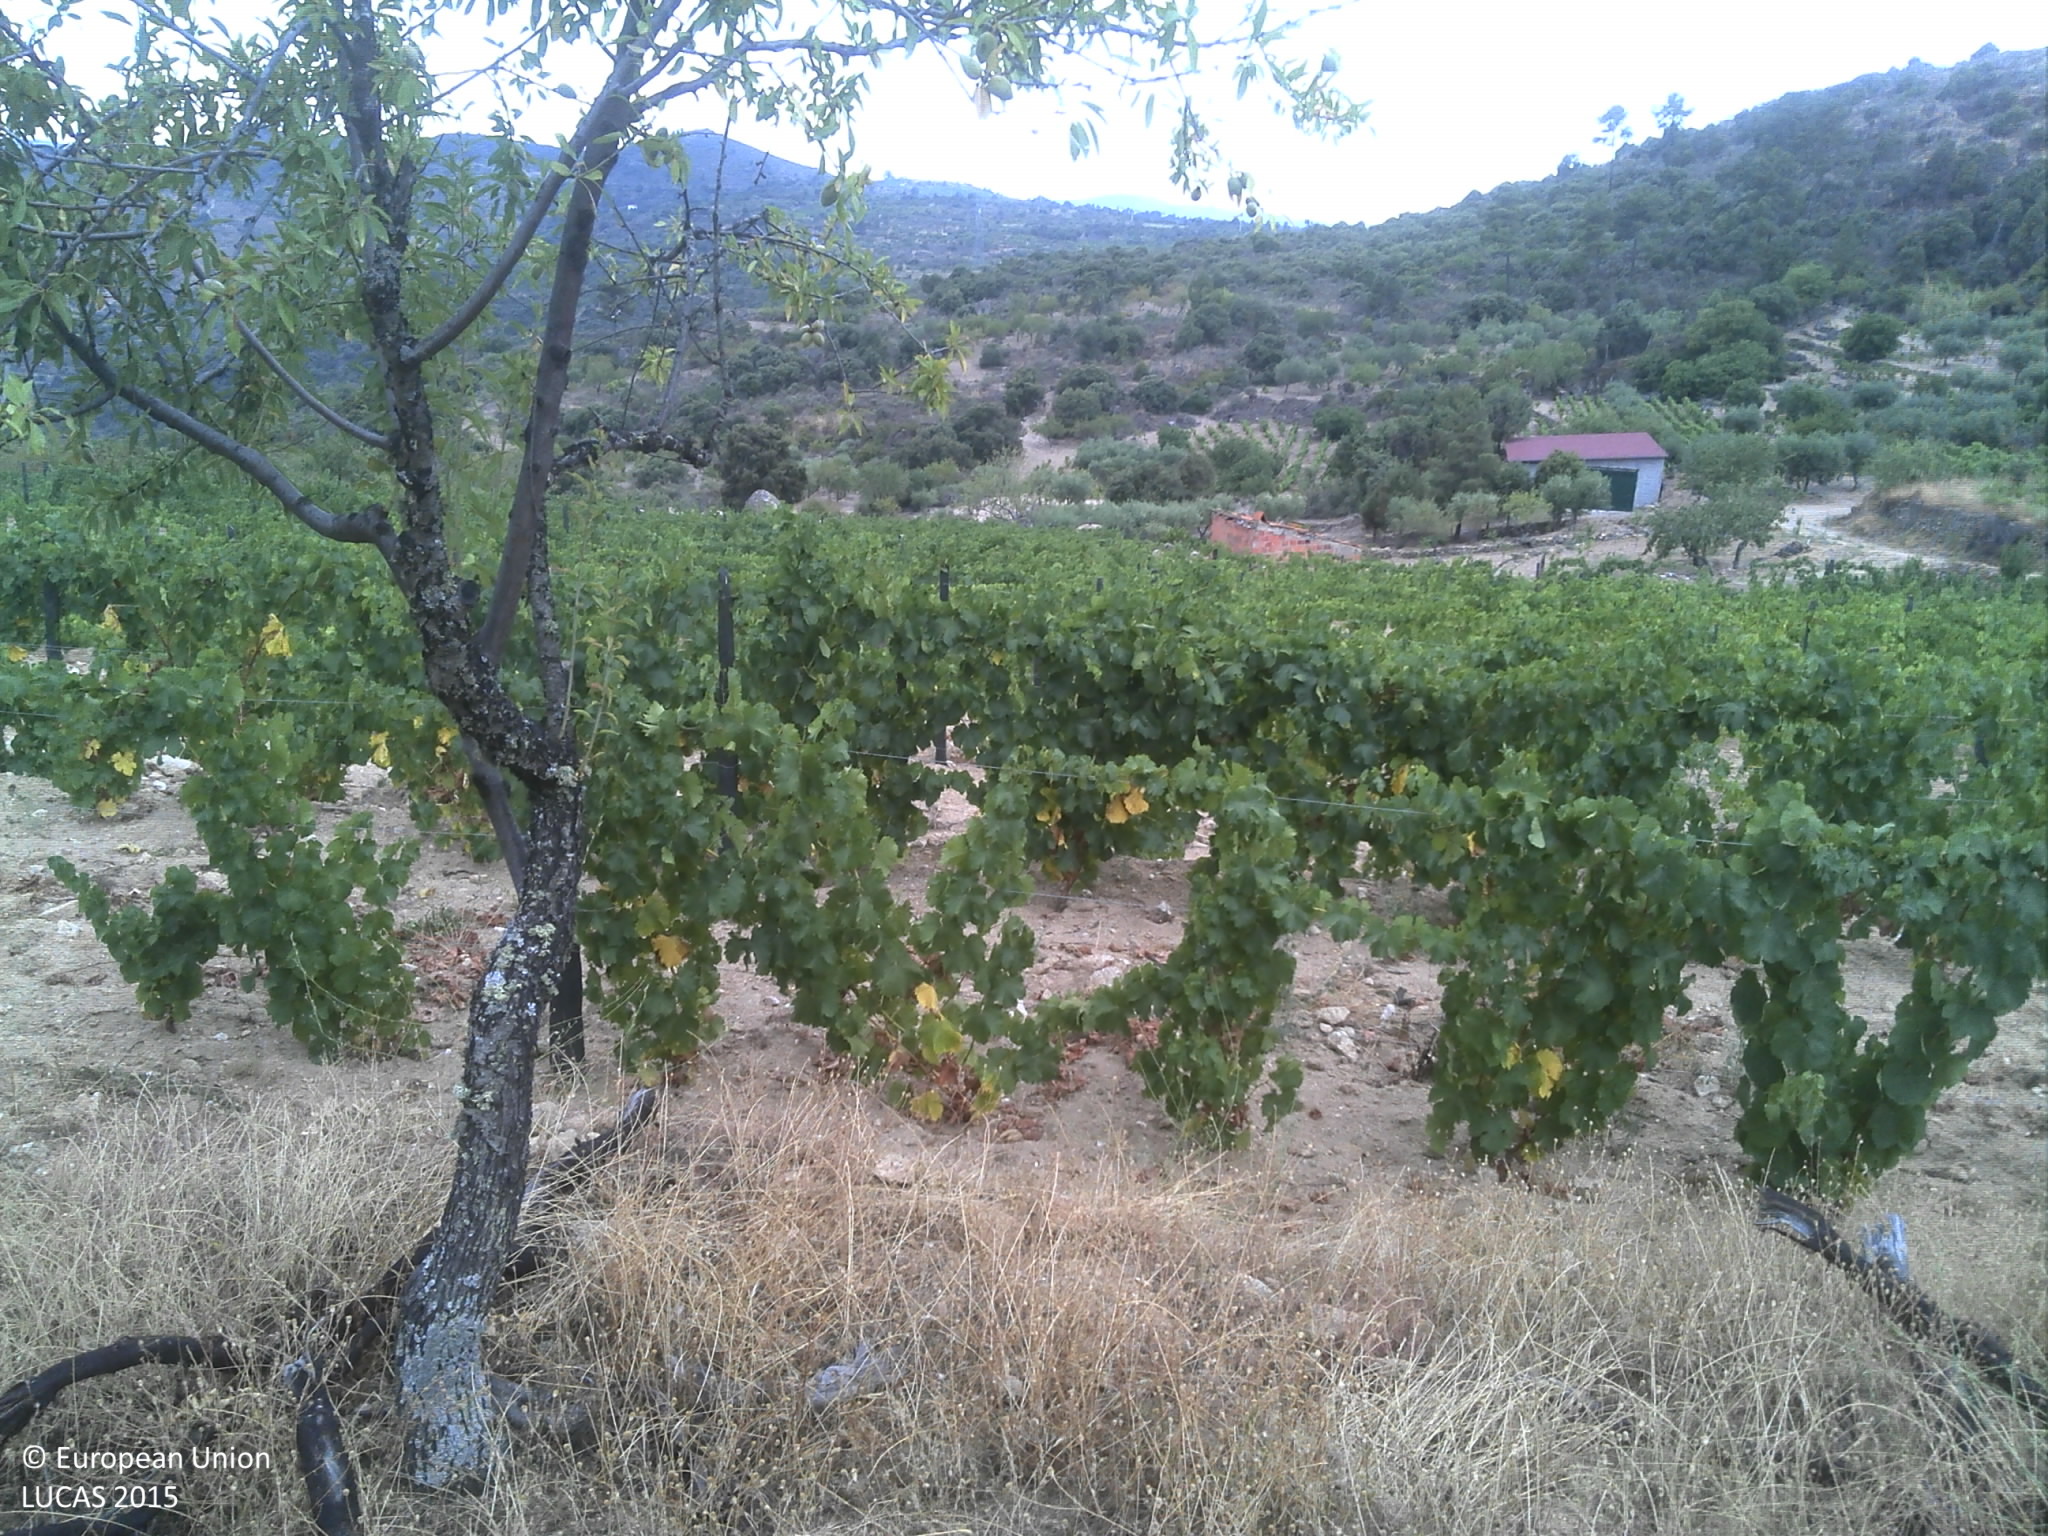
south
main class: Cropland
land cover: Nuts trees
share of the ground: 10 - 25 %
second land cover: Grassland without tree/shrub cover
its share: > 75 %
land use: Agriculture (excluding fallow land and kitchen gardens)
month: July
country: PT
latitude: 41.0880
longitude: -7.2446
